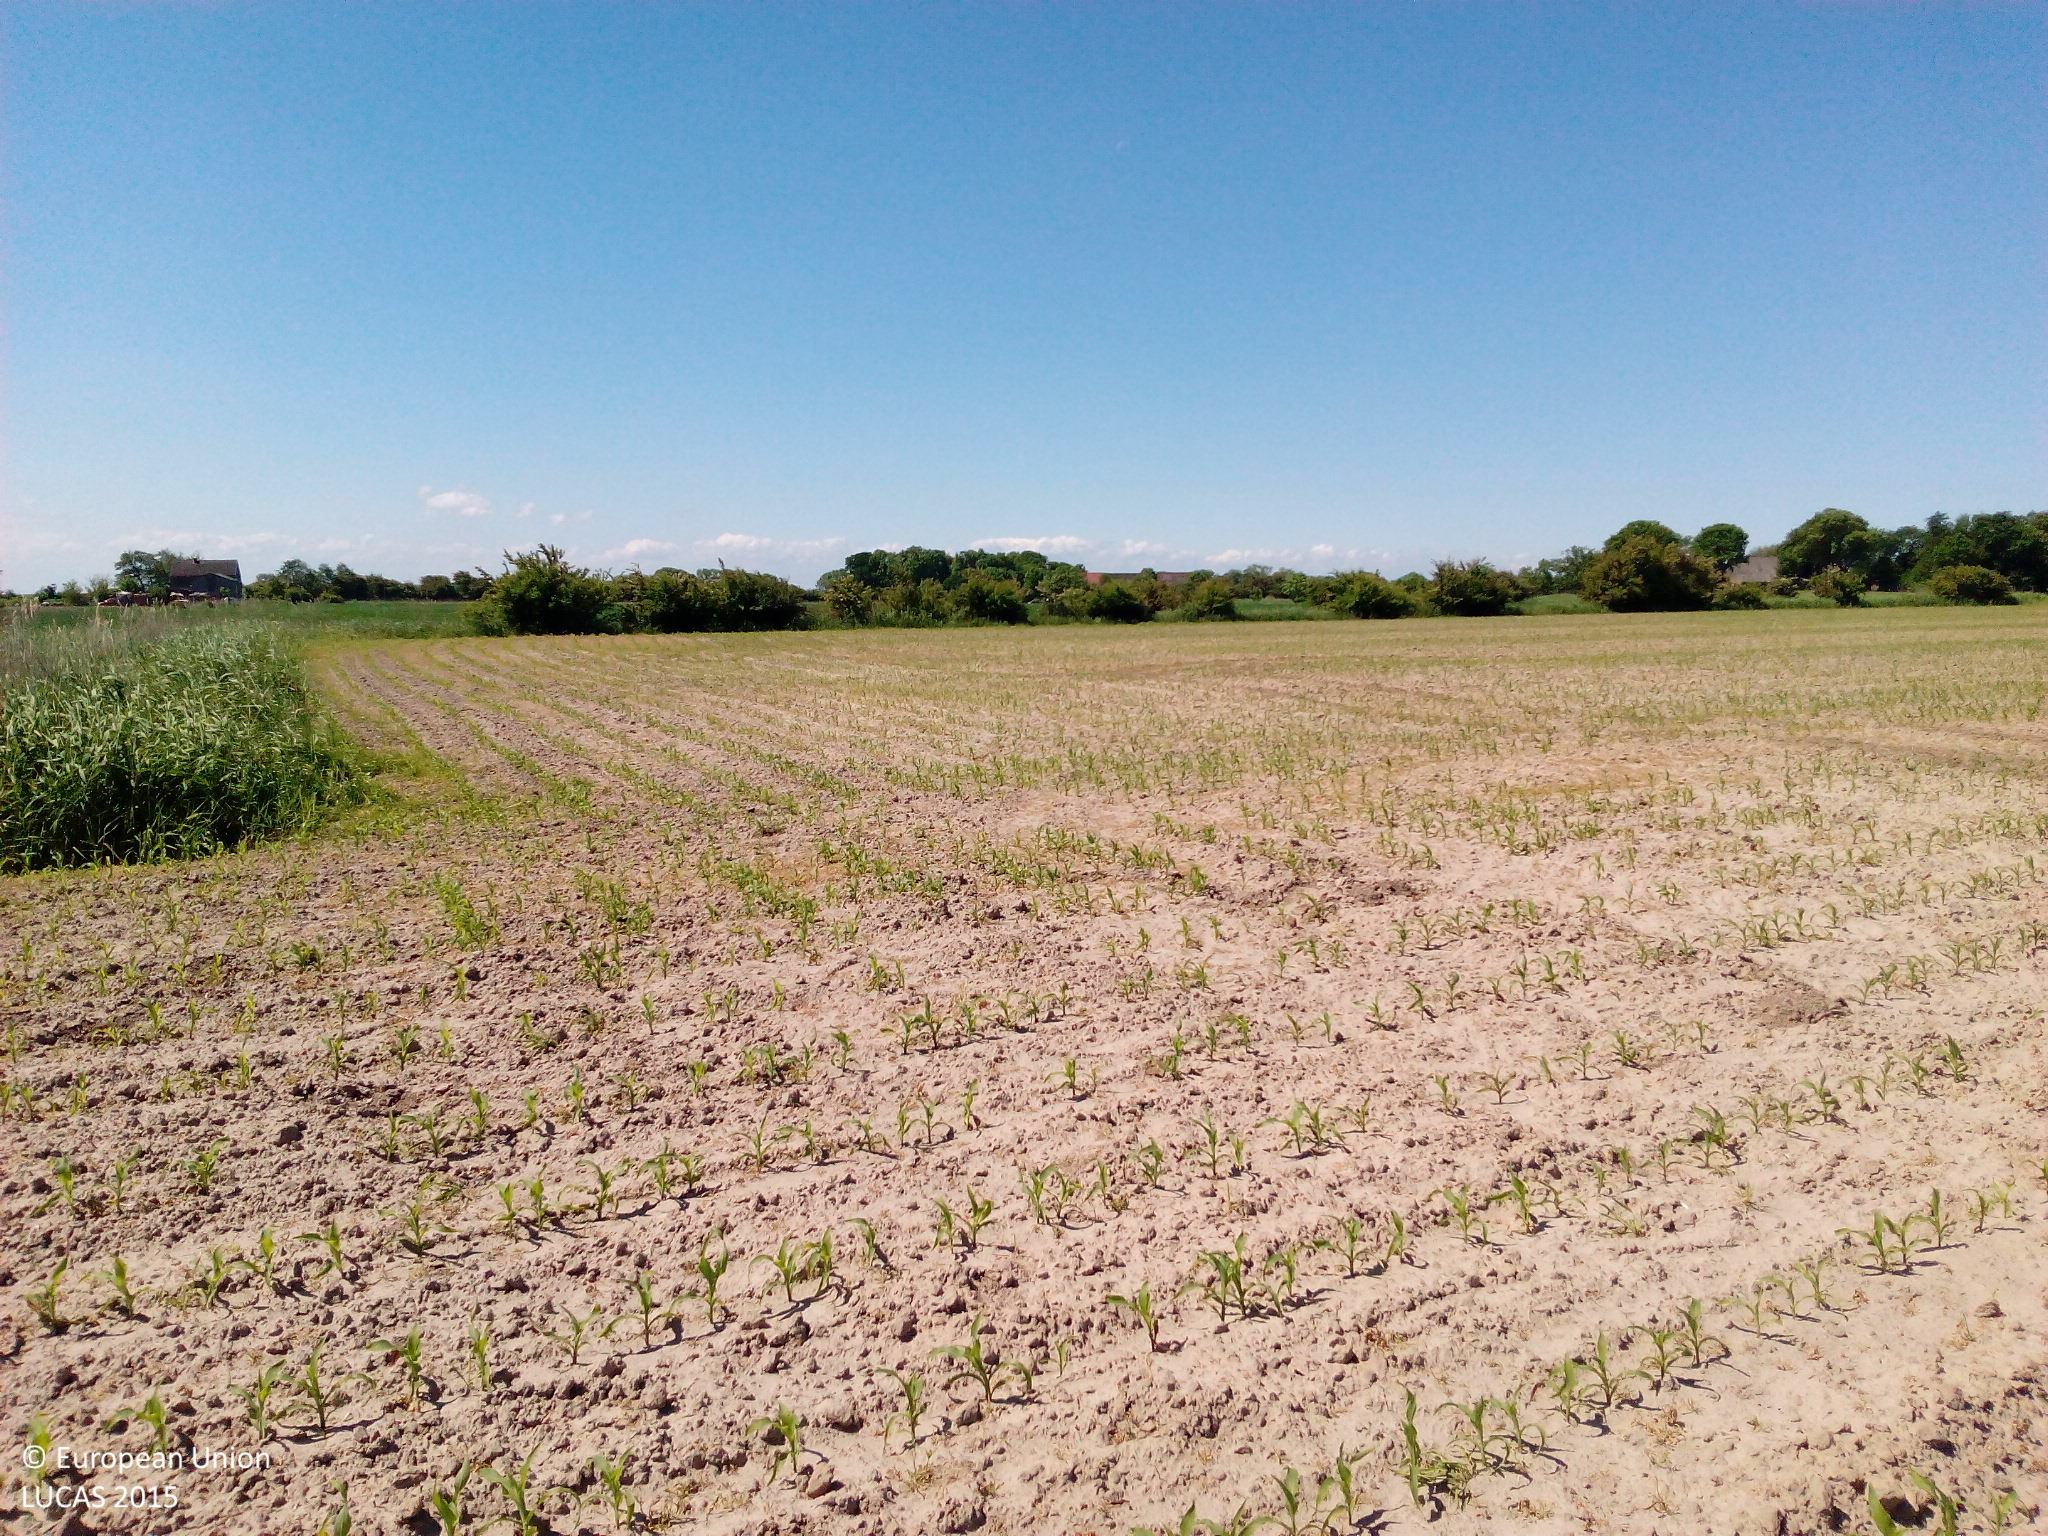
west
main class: Cropland
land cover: Maize
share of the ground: < 10 %
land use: Agriculture (excluding fallow land and kitchen gardens)
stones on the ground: < 10 %
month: June
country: DE
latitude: 53.6803
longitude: 8.5018
